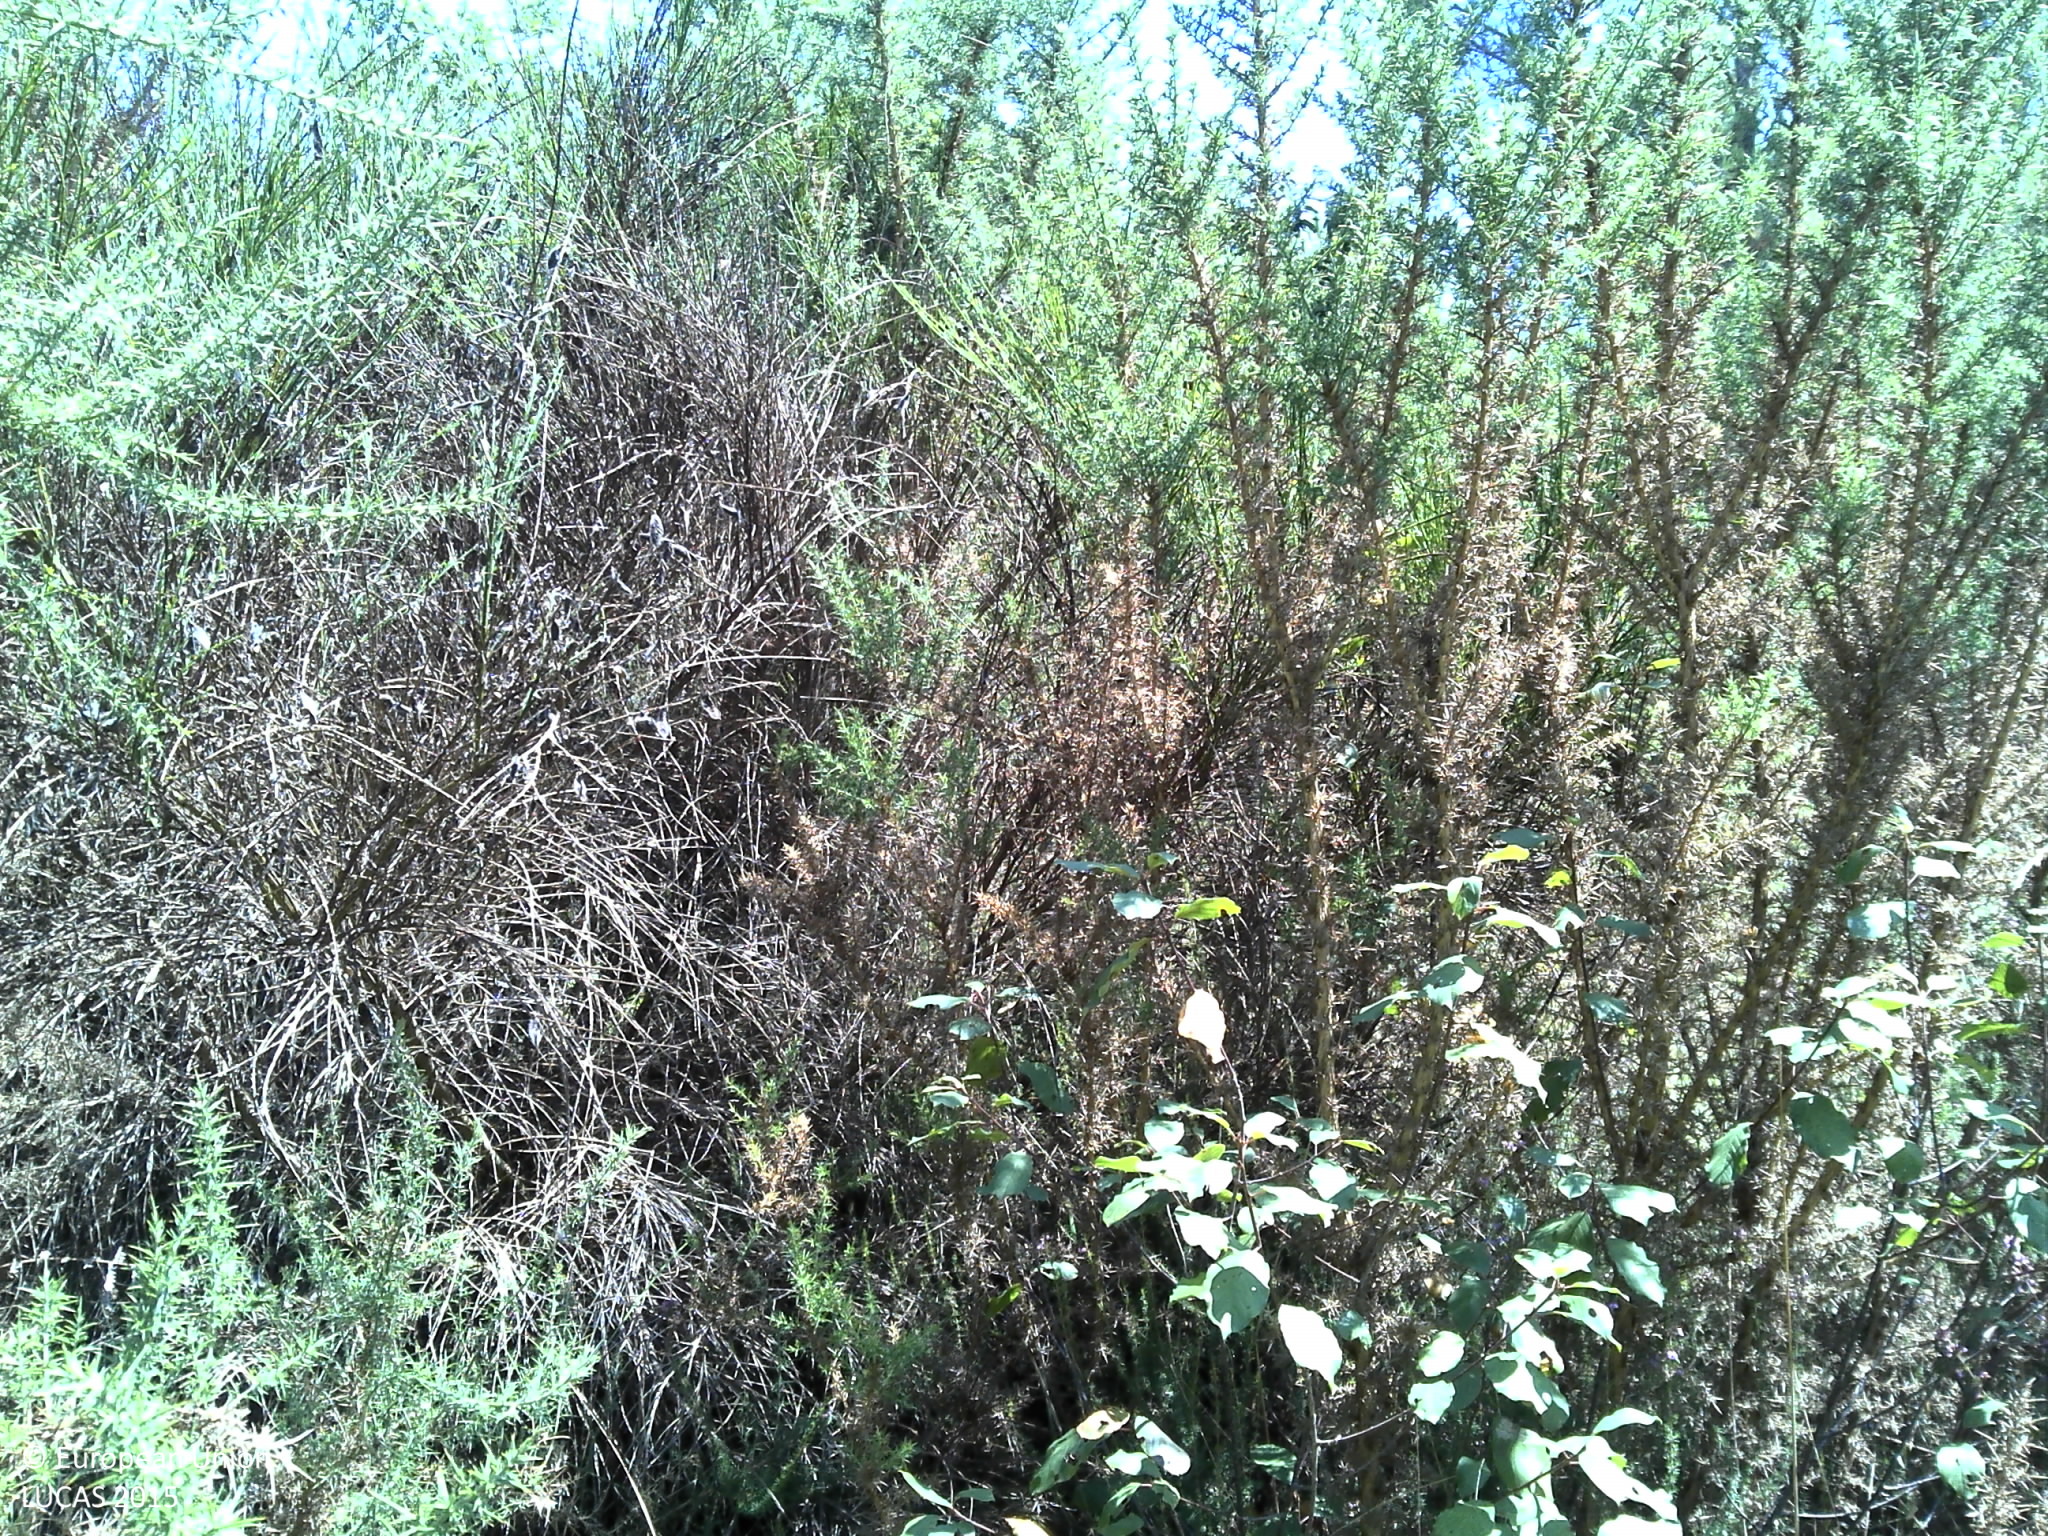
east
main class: Woodland
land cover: Pine dominated coniferous woodland
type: coniferous forest of the mediterranean region
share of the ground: > 75 %
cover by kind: shrubs 60 %, coniferous forest trees 40 %
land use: Forestry
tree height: < 5 m
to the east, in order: Pine dominated coniferous woodland; Ditches and canals; Fences; Tracks; Pine dominated coniferous woodland; Pine dominated mixed woodland; Tracks; Fences; Ditches and canals; Pine dominated coniferous woodland; Ditches and canals; Grass margins; Tracks; Grass margins; Ditches and canals; Pine dominated coniferous woodland
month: August
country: FR
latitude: 45.0270
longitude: -0.7459
